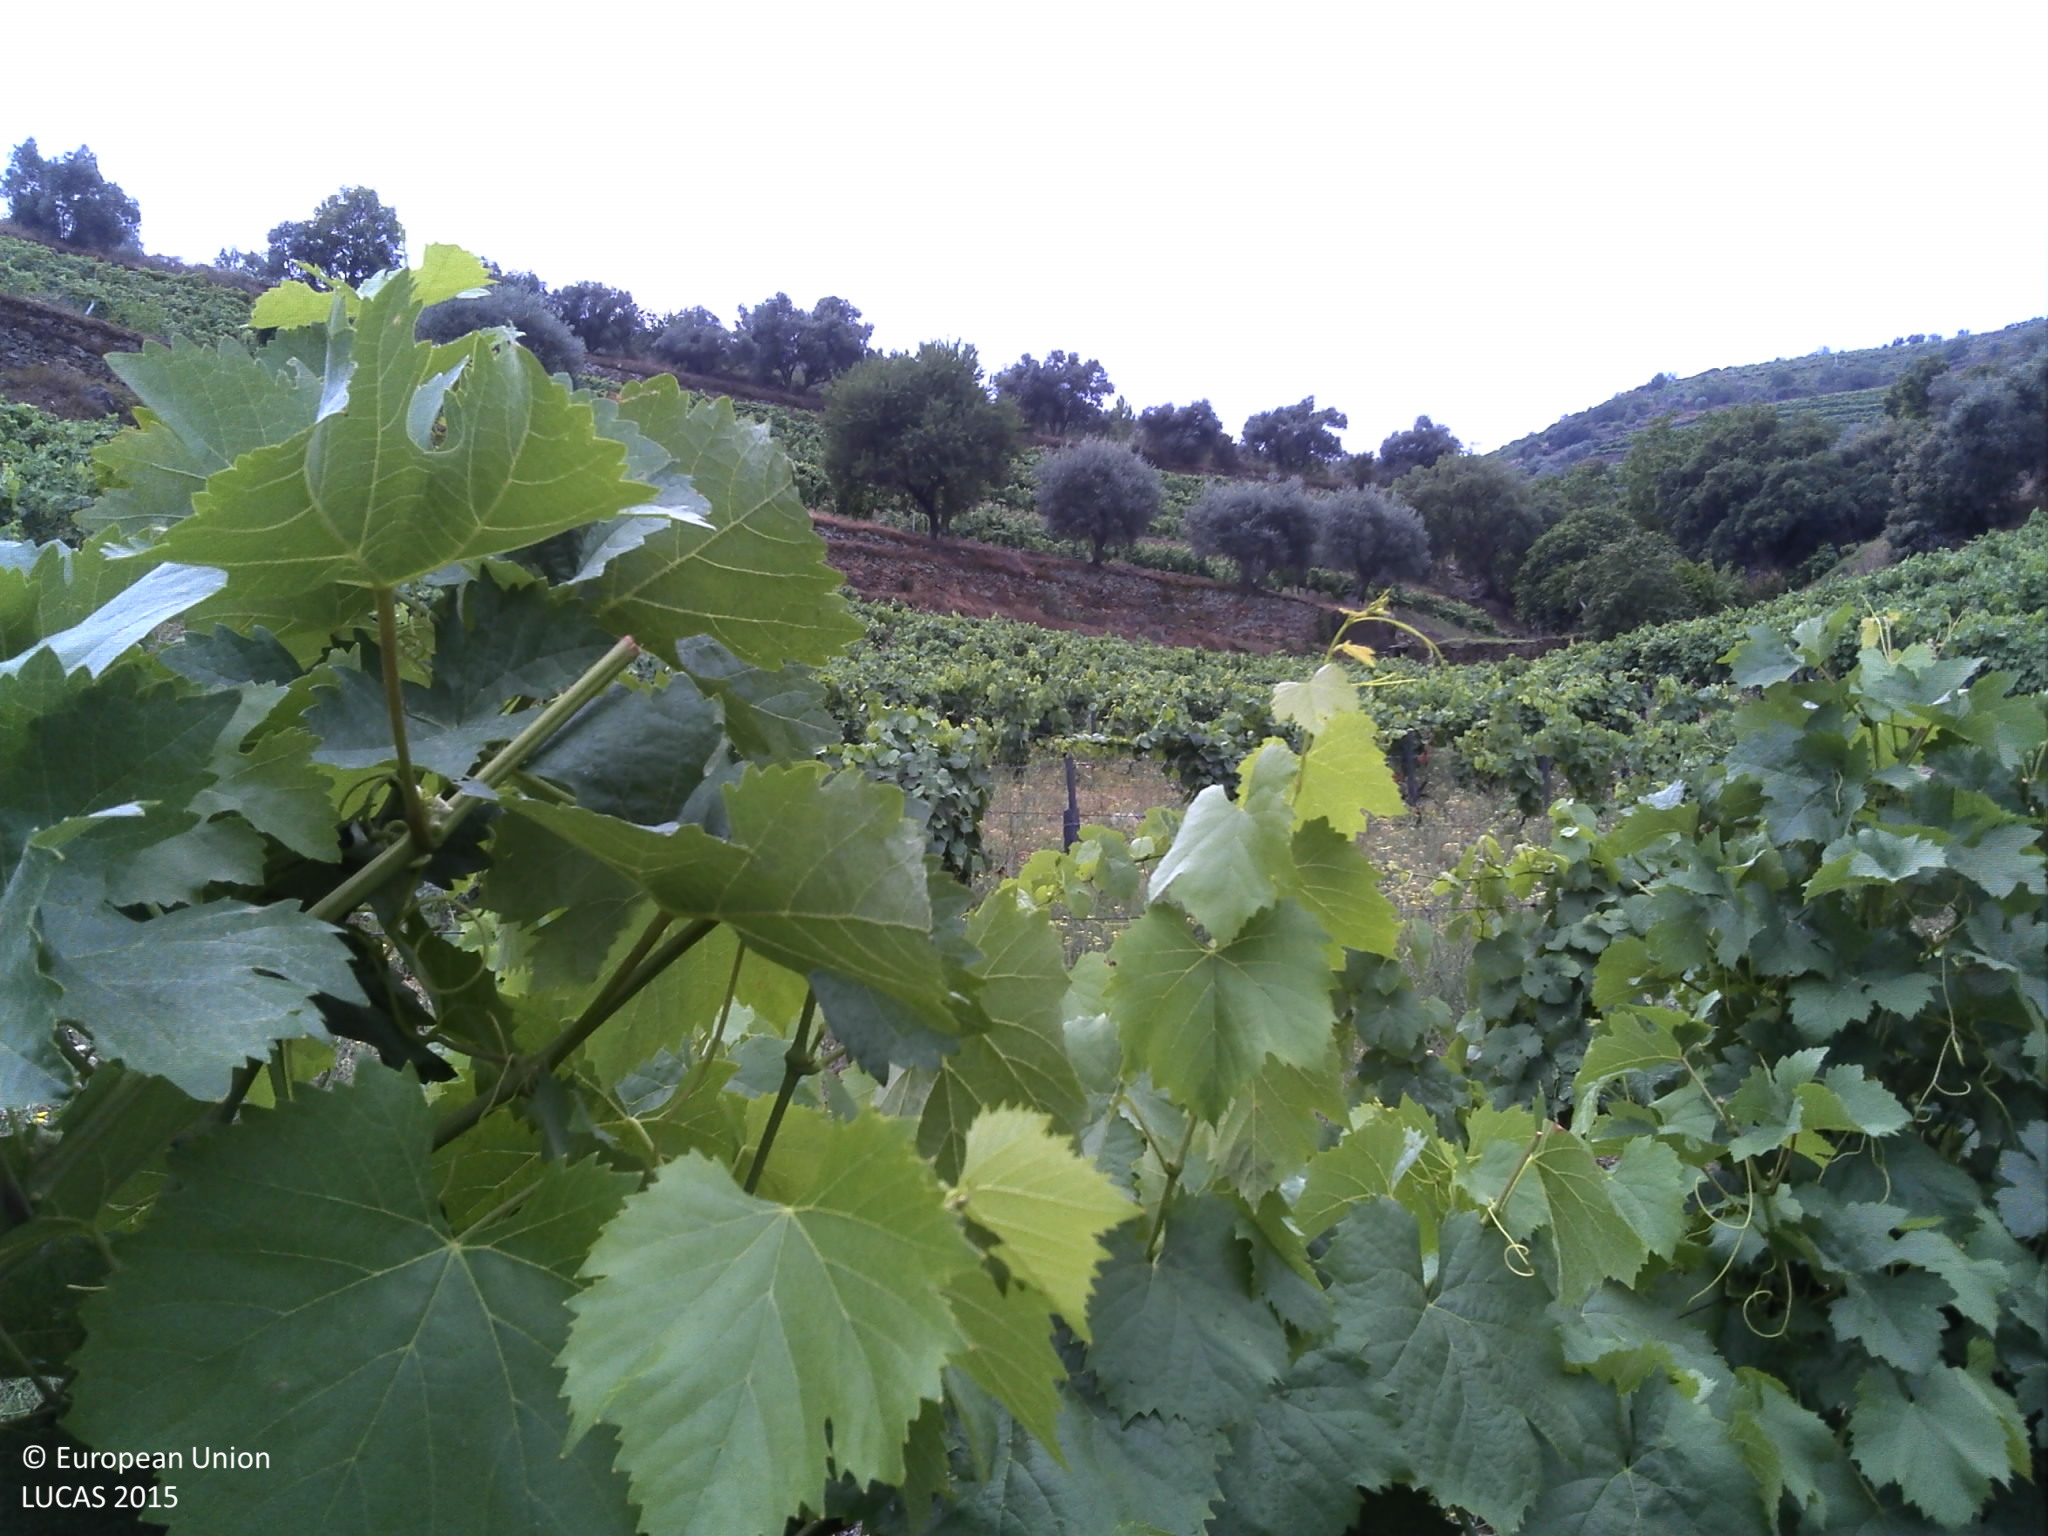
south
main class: Cropland
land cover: Vineyards
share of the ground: 10 - 25 %
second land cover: Spontaneously vegetated surfaces
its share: 50 - 75 %
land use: Agriculture (excluding fallow land and kitchen gardens)
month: June
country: PT
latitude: 41.2037
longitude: -7.4242
